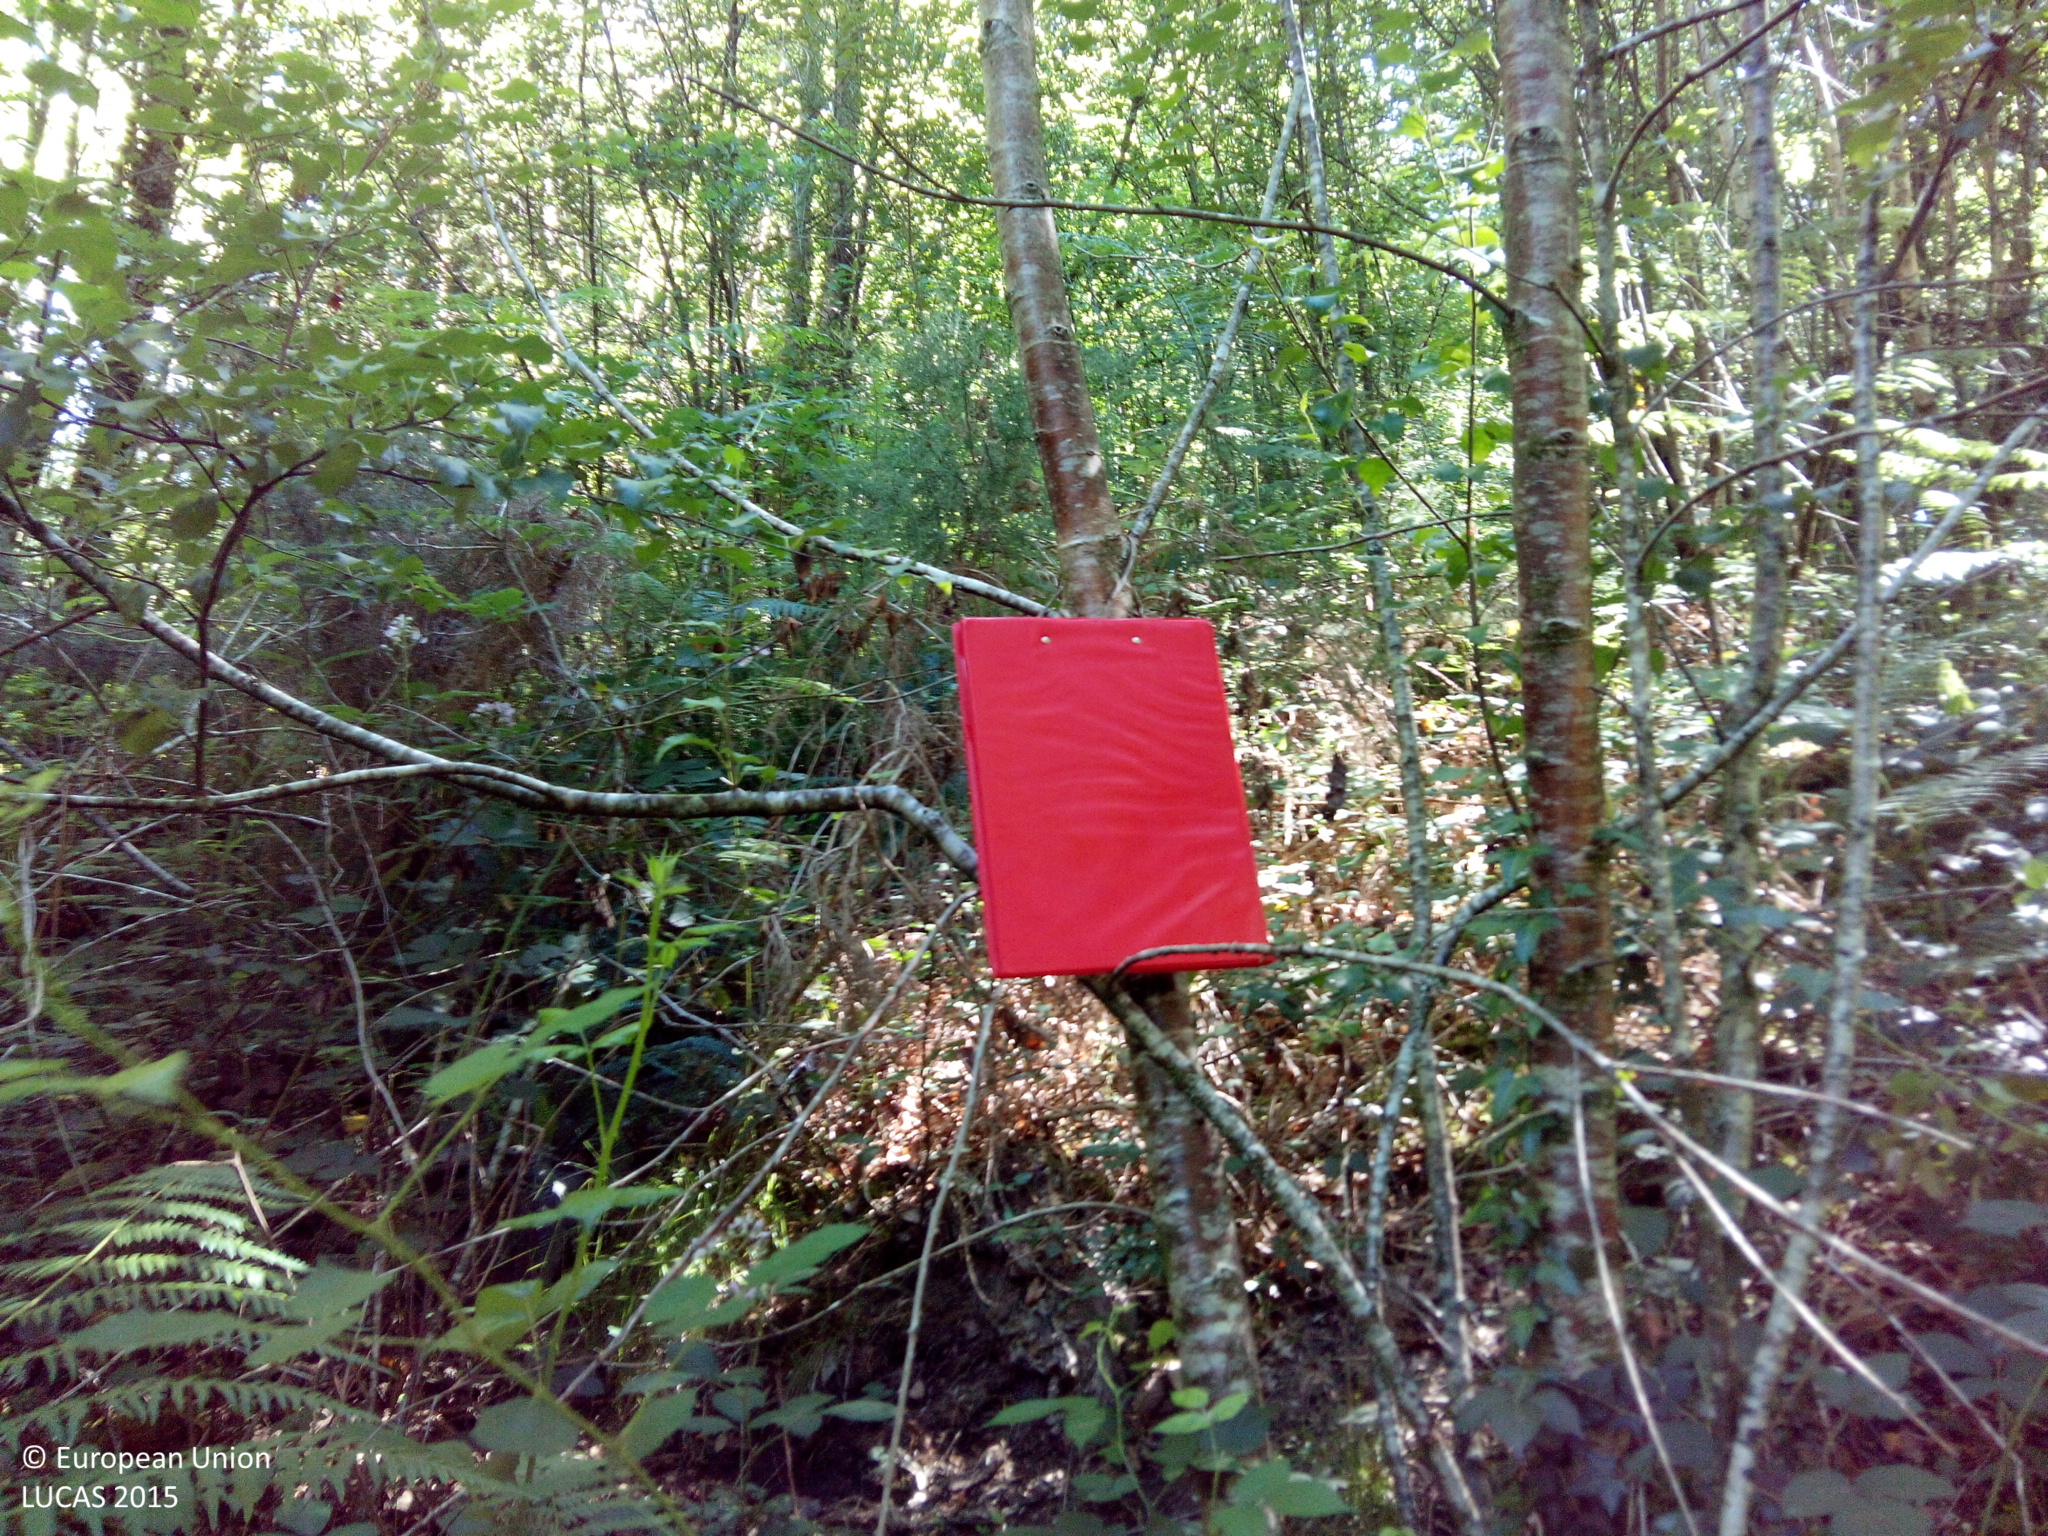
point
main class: Woodland
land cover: Broadleaved woodland
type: acidophilous oak and oak-birch forest
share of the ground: > 75 %
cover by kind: broadleaved forest trees 100 %
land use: Forestry
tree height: > 5 m
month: June
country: ES
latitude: 42.5492
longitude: -8.3492
